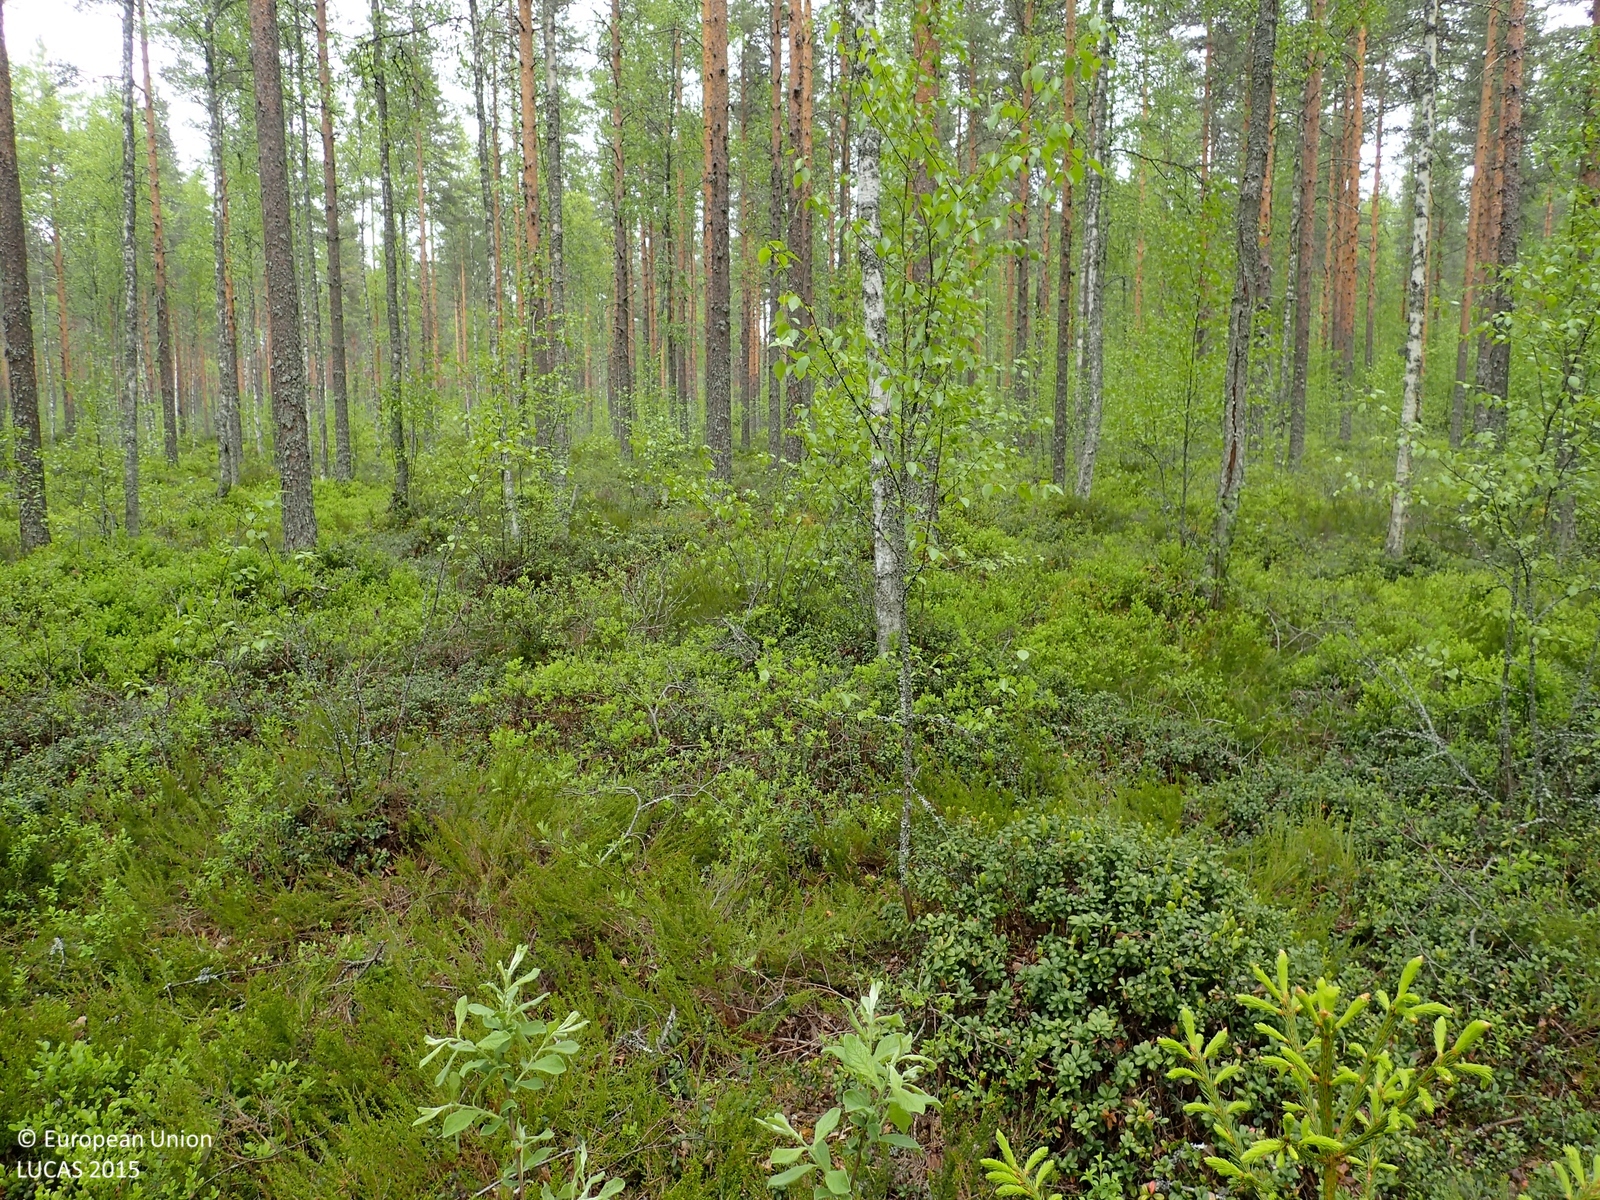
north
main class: Woodland
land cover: Pine dominated mixed woodland
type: boreal forest
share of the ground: 50 - 75 %
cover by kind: shrubs 40 %, coniferous forest trees 30 %, broadleaved forest trees 30 %
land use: Forestry
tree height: > 5 m
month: June
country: FI
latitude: 62.2702
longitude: 22.5220
